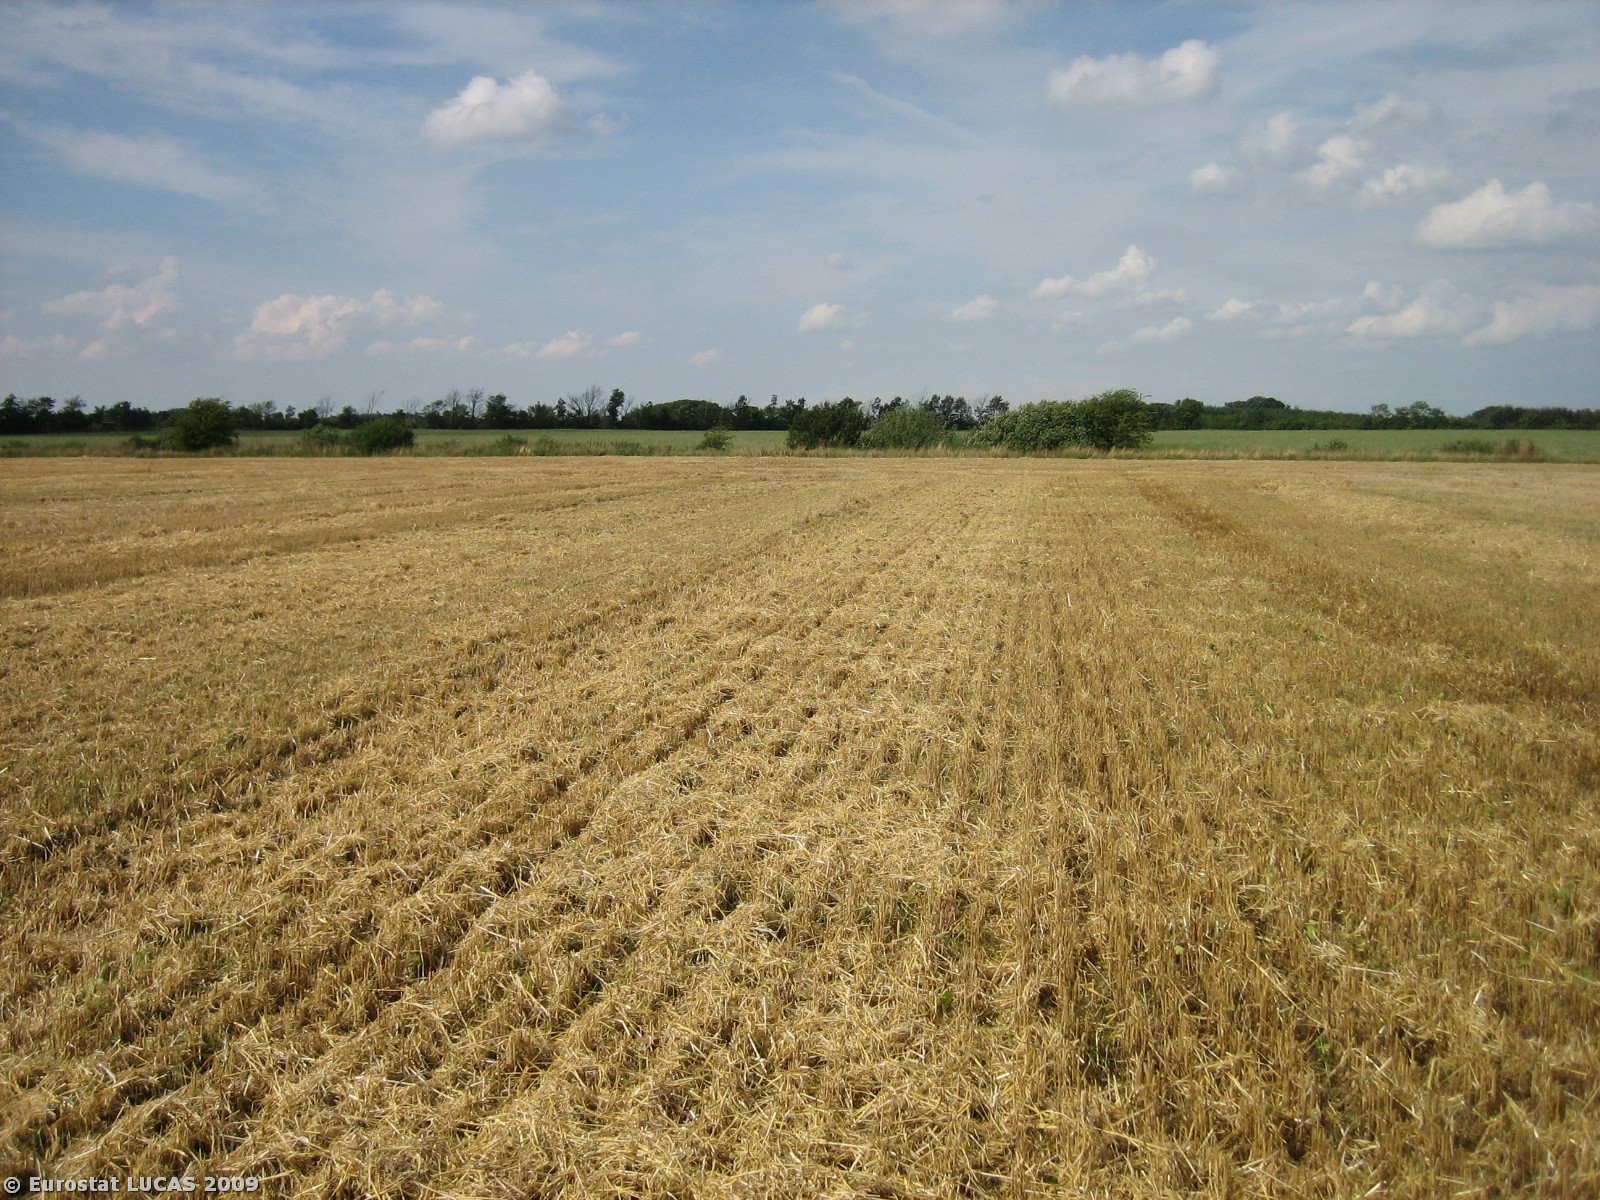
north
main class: Cropland
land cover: Barley
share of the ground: > 75 %
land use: Agriculture (excluding fallow land and kitchen gardens)
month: July
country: DK
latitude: 55.7687
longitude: 8.8057
